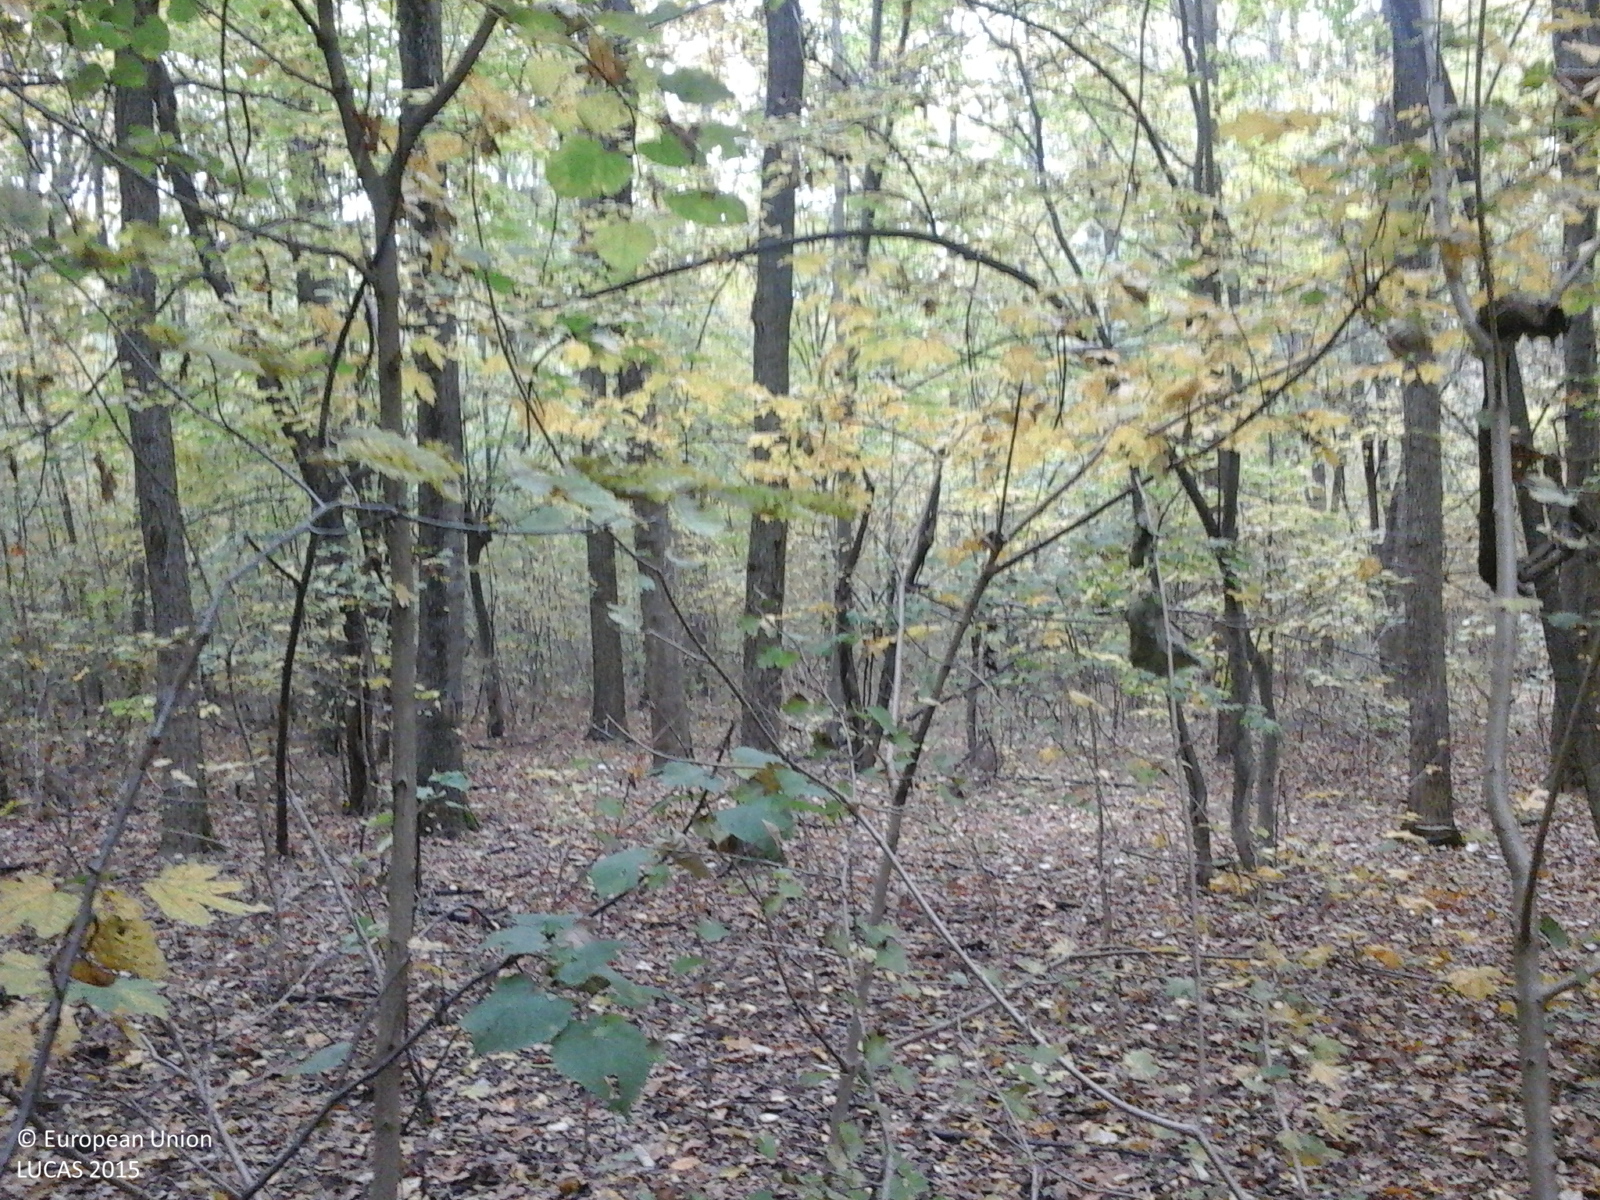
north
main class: Woodland
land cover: Broadleaved woodland
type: beech forest
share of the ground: > 75 %
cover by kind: broadleaved forest trees 100 %
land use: Forestry
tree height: > 5 m
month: October
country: RO
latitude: 44.7287
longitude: 26.0282
